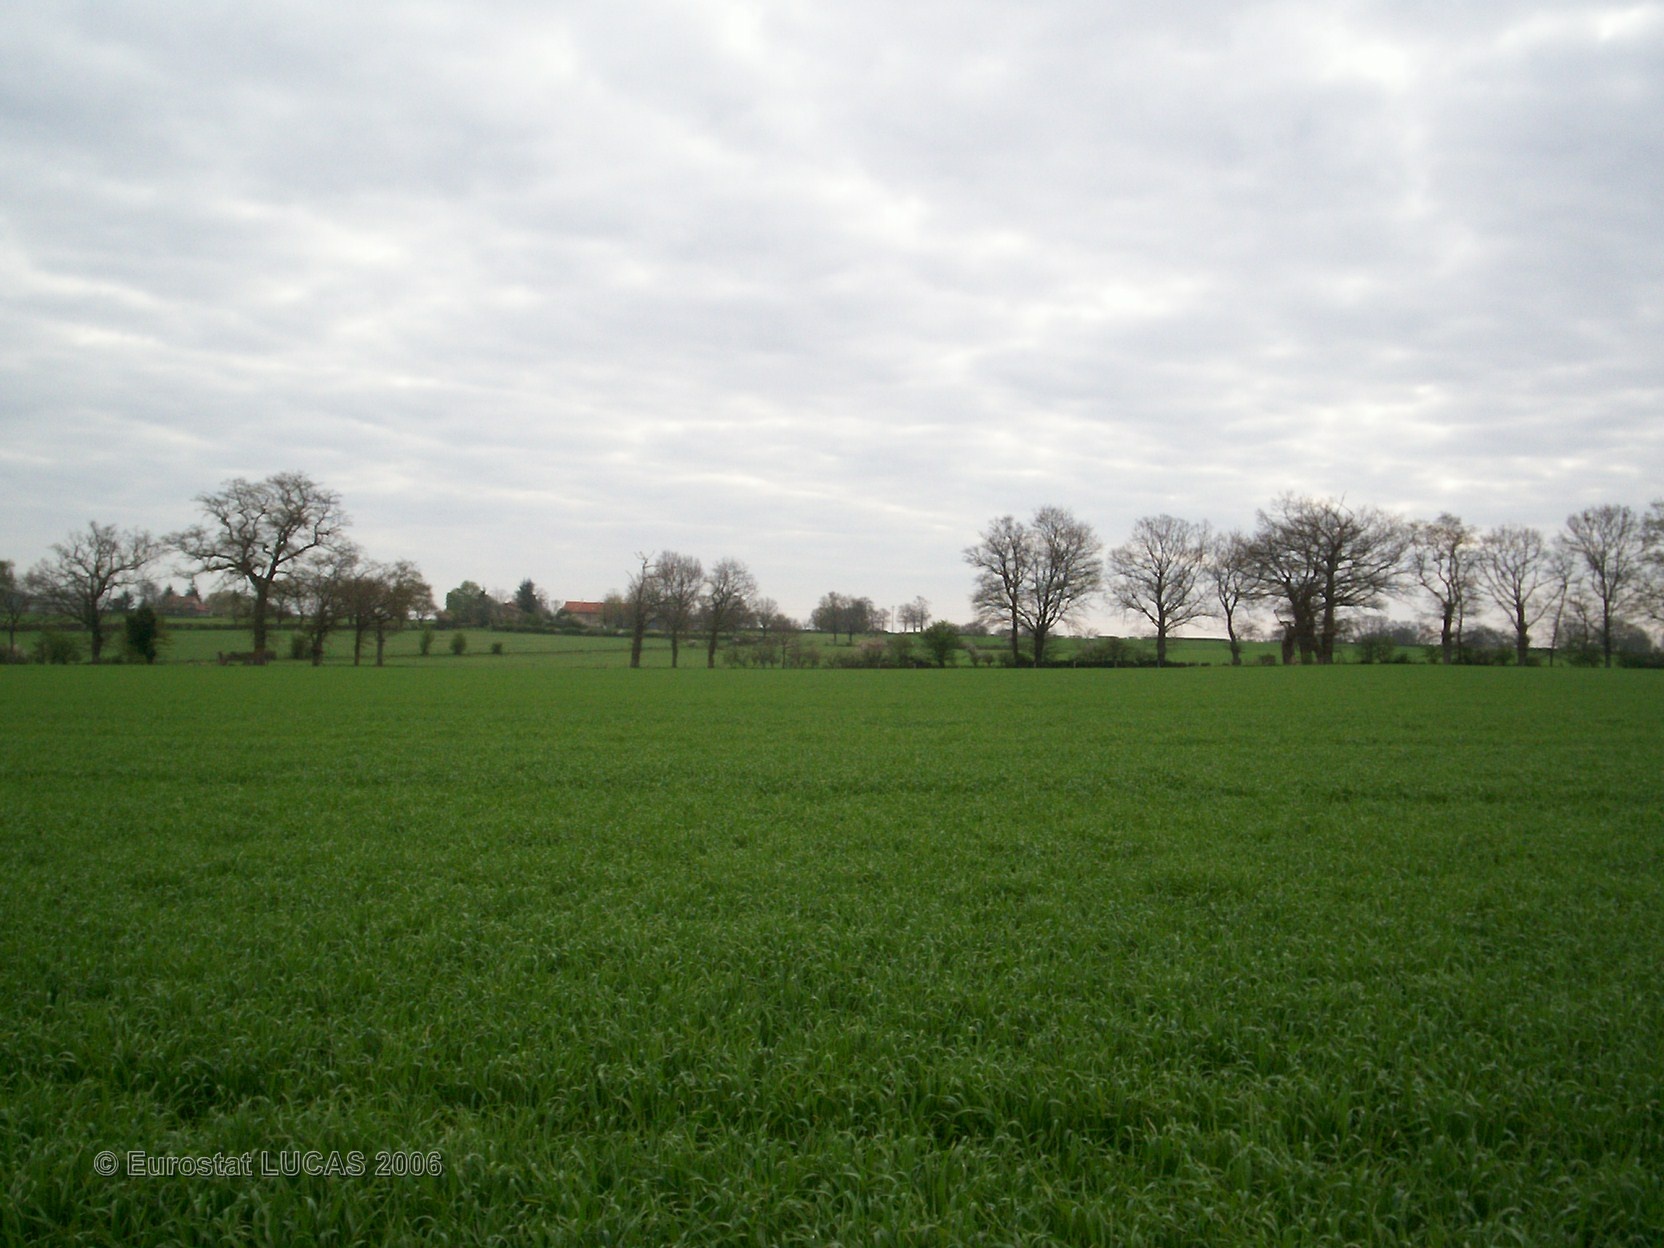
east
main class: Cropland
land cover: Barley
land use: Agriculture (excluding fallow land and kitchen gardens)
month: April
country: FR
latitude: 46.1492
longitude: 0.5459
